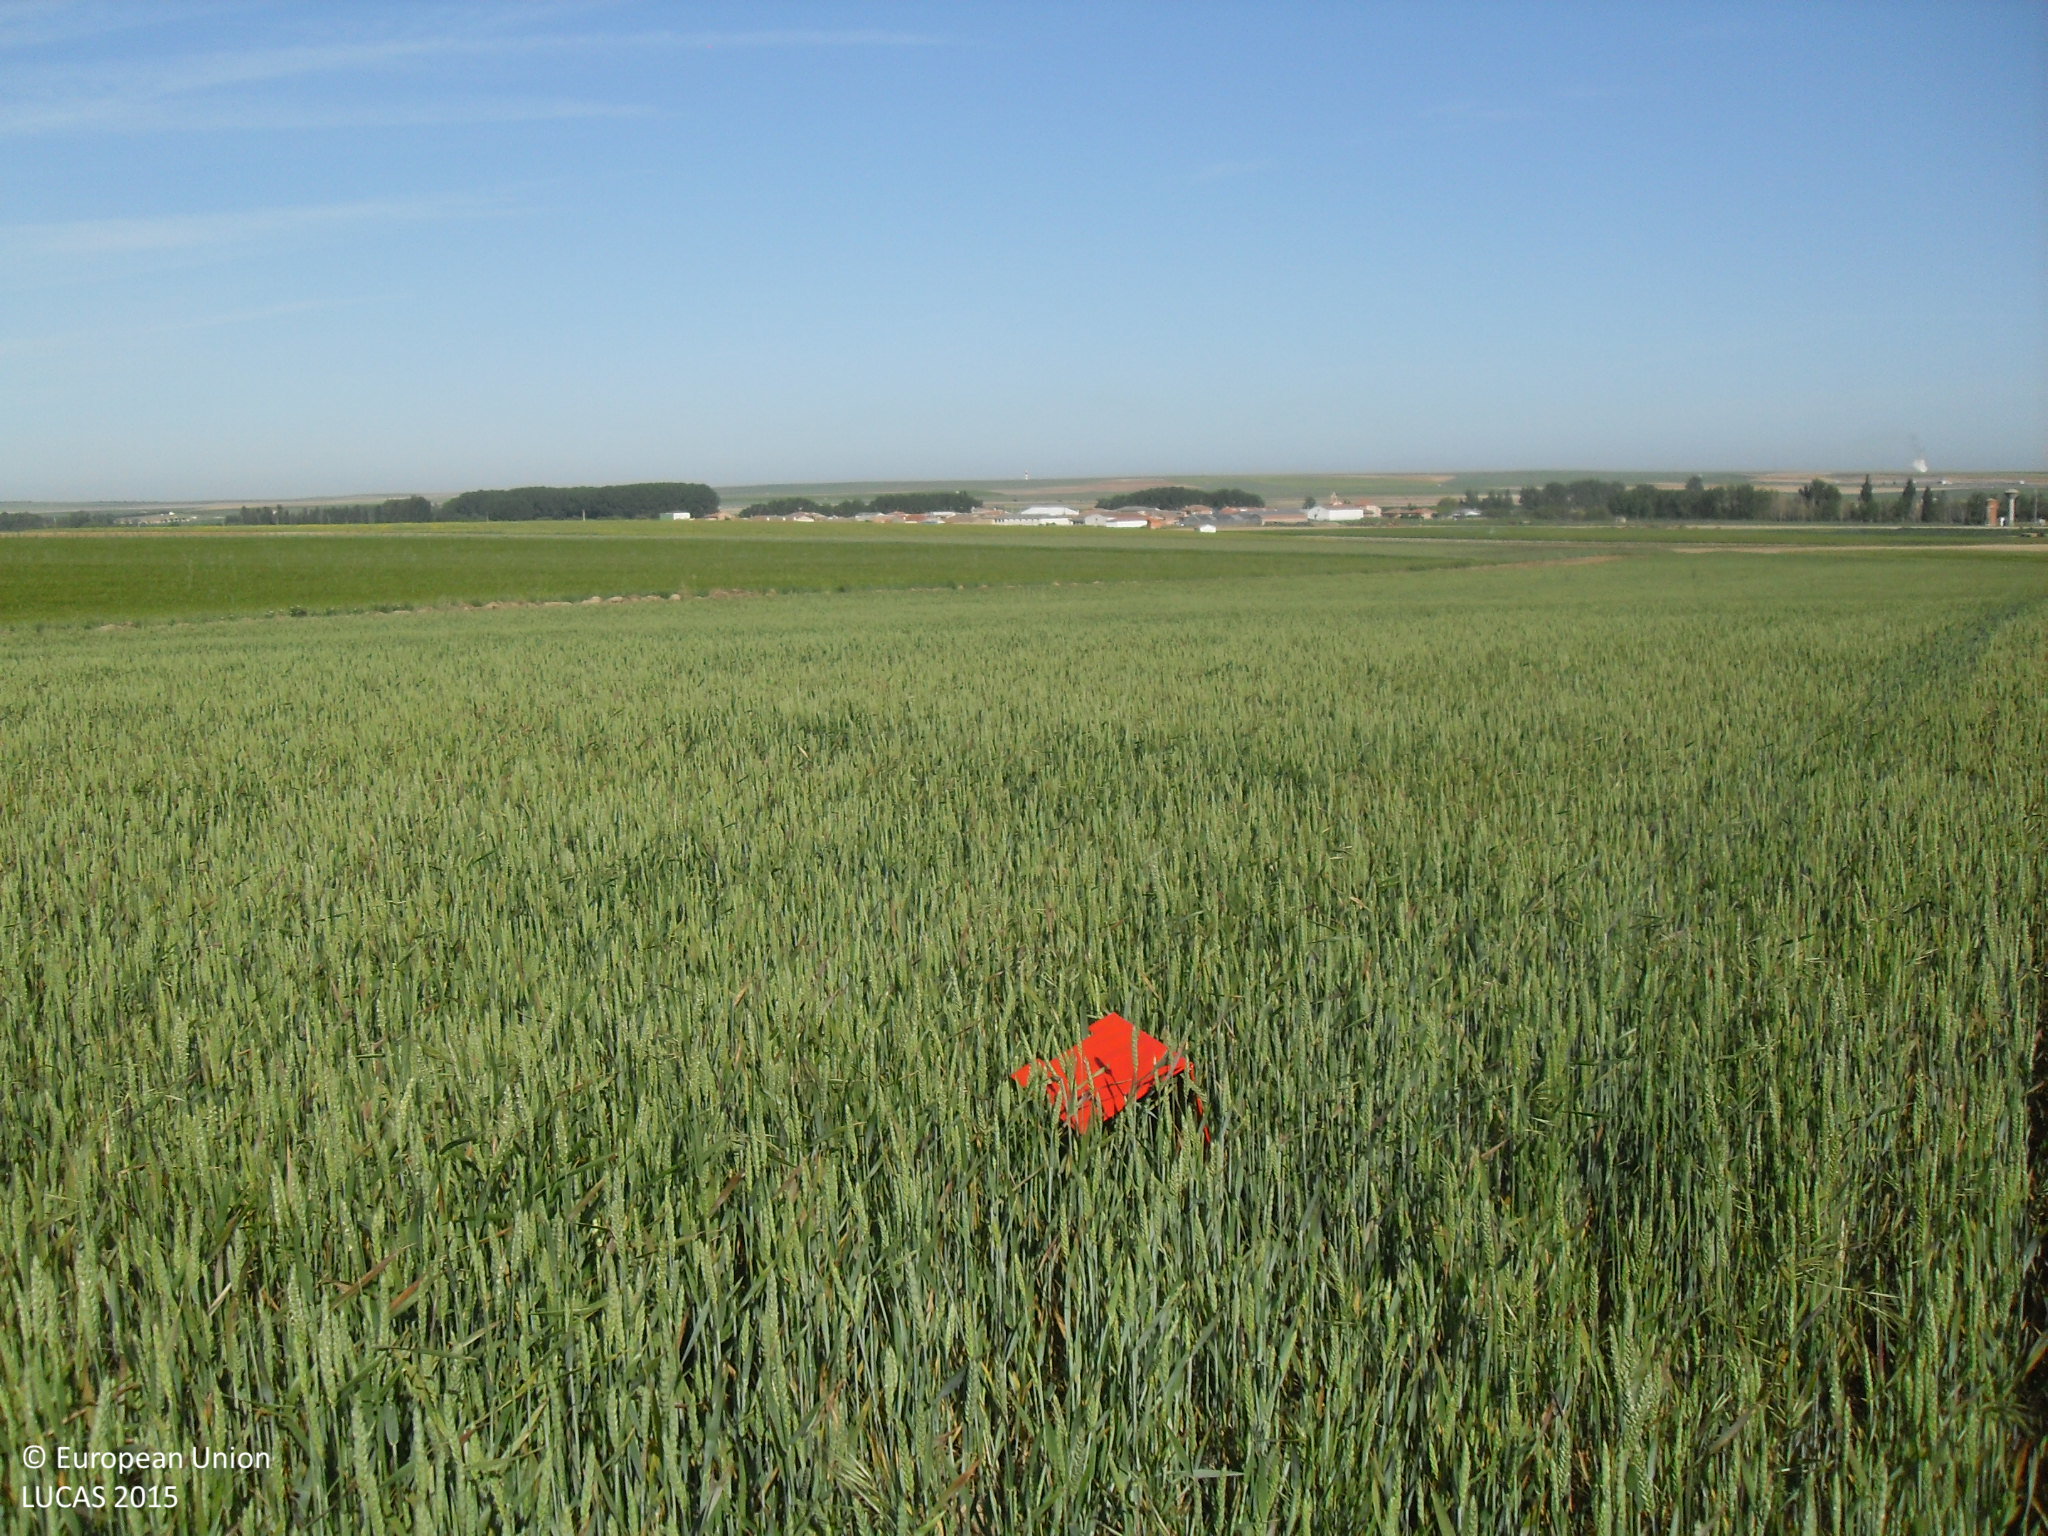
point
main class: Cropland
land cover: Common wheat
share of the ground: > 75 %
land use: Agriculture (excluding fallow land and kitchen gardens)
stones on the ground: 25 - 50 %
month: May
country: ES
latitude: 40.9069
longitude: -5.3494
